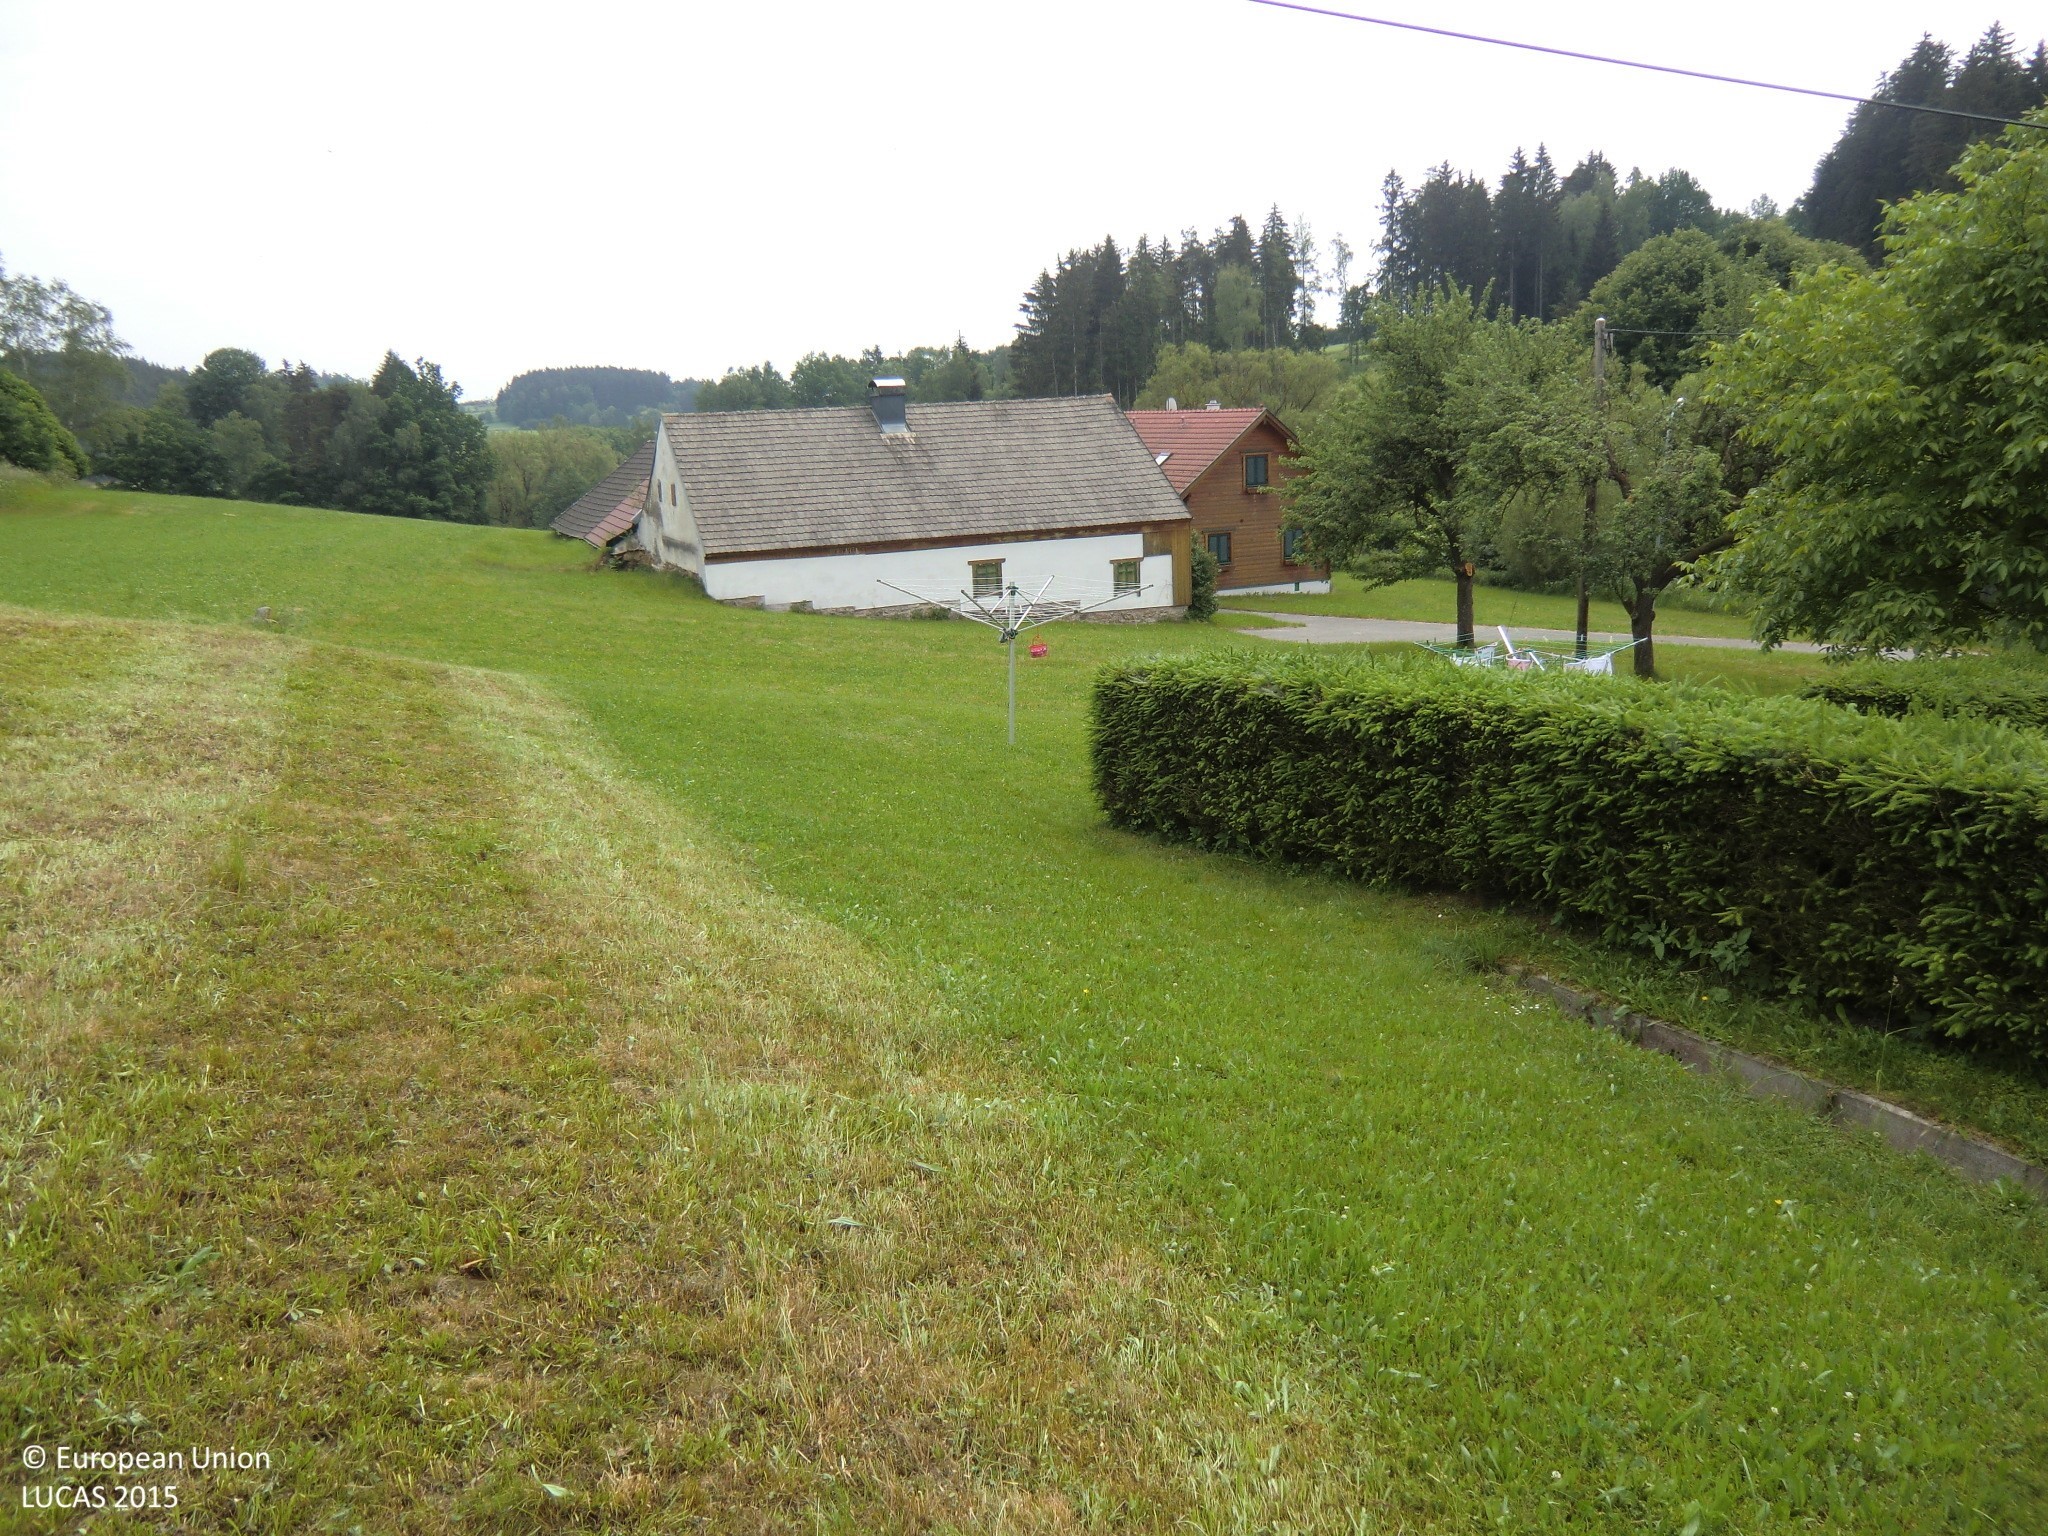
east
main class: Grassland
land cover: Grassland without tree/shrub cover
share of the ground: > 75 %
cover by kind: herbaceous plants 100 %
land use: Agriculture (excluding fallow land and kitchen gardens)
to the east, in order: Grassland without tree/shrub cover; Electric lines; Grassland without tree/shrub cover; Other mixed woodland
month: June
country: AT
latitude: 48.6313
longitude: 15.0358
